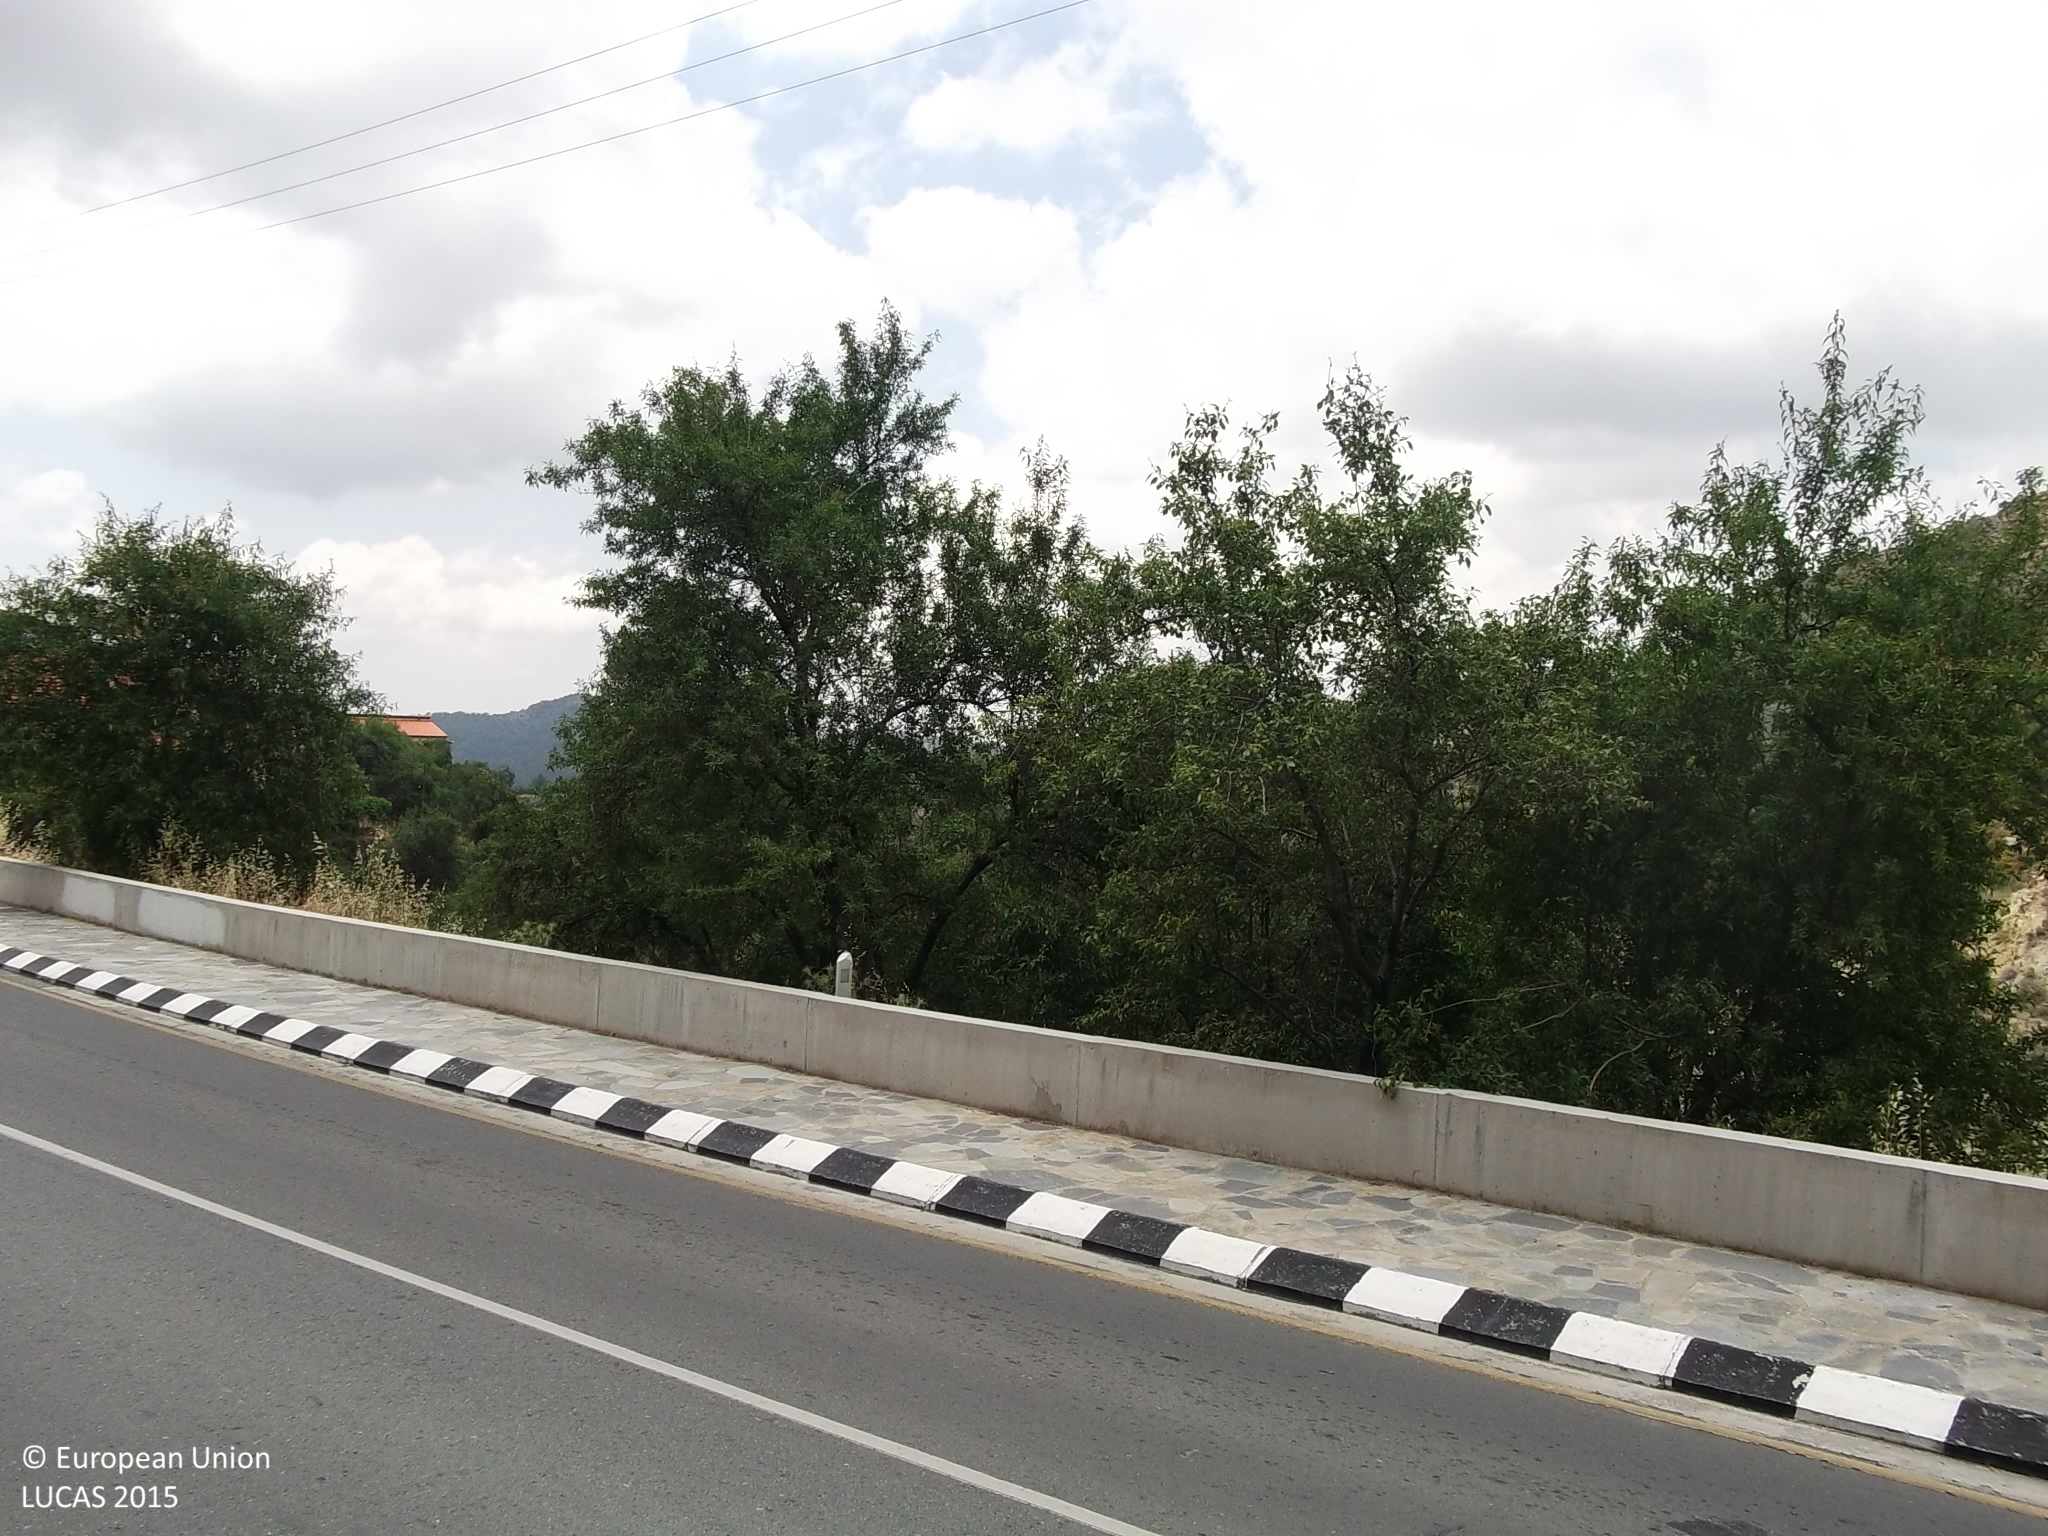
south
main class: Cropland
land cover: Nuts trees
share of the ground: 25 - 50 %
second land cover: Grassland without tree/shrub cover
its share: > 75 %
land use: Agriculture (excluding fallow land and kitchen gardens)
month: June
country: CY
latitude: 34.8971
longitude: 32.9634
